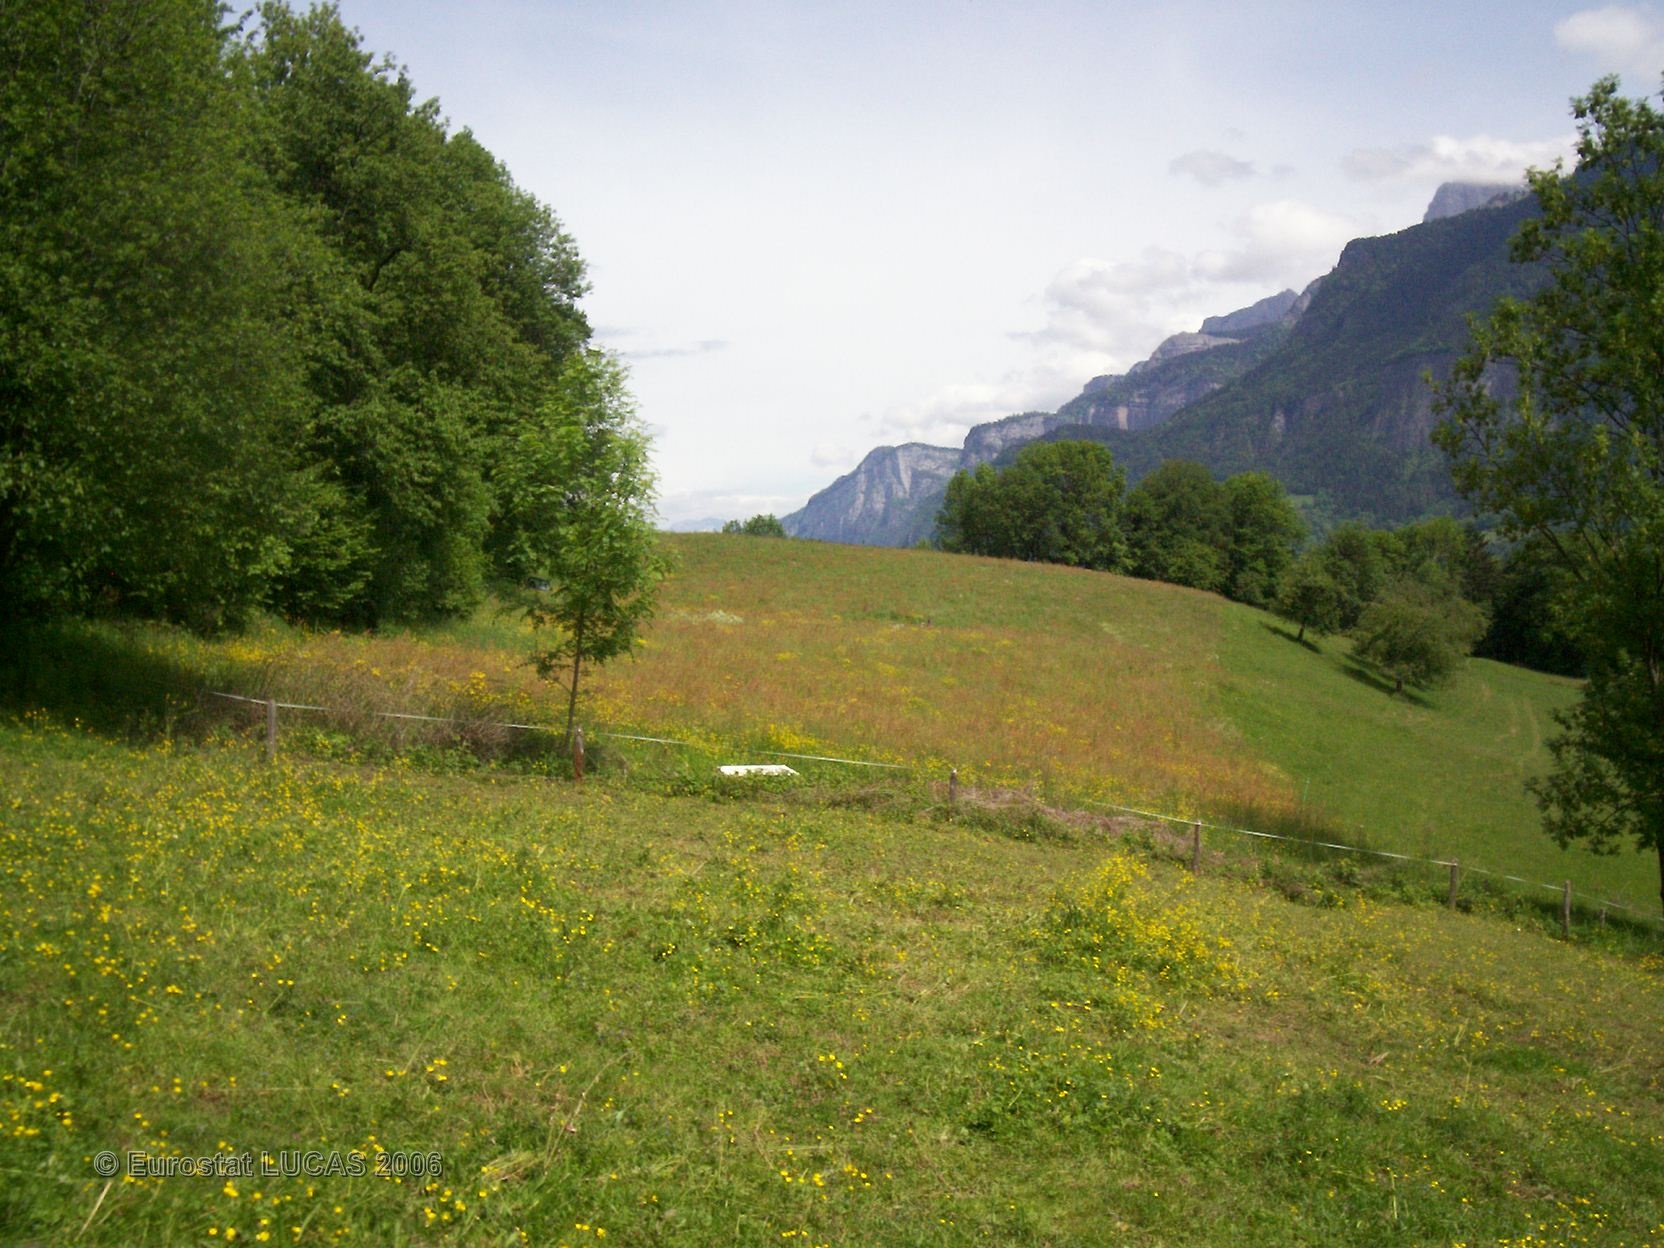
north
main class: Grassland
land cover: Grassland with sparse tree/shrub cover
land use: Agriculture (excluding fallow land and kitchen gardens)
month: May
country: FR
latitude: 45.9198
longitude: 6.6386
